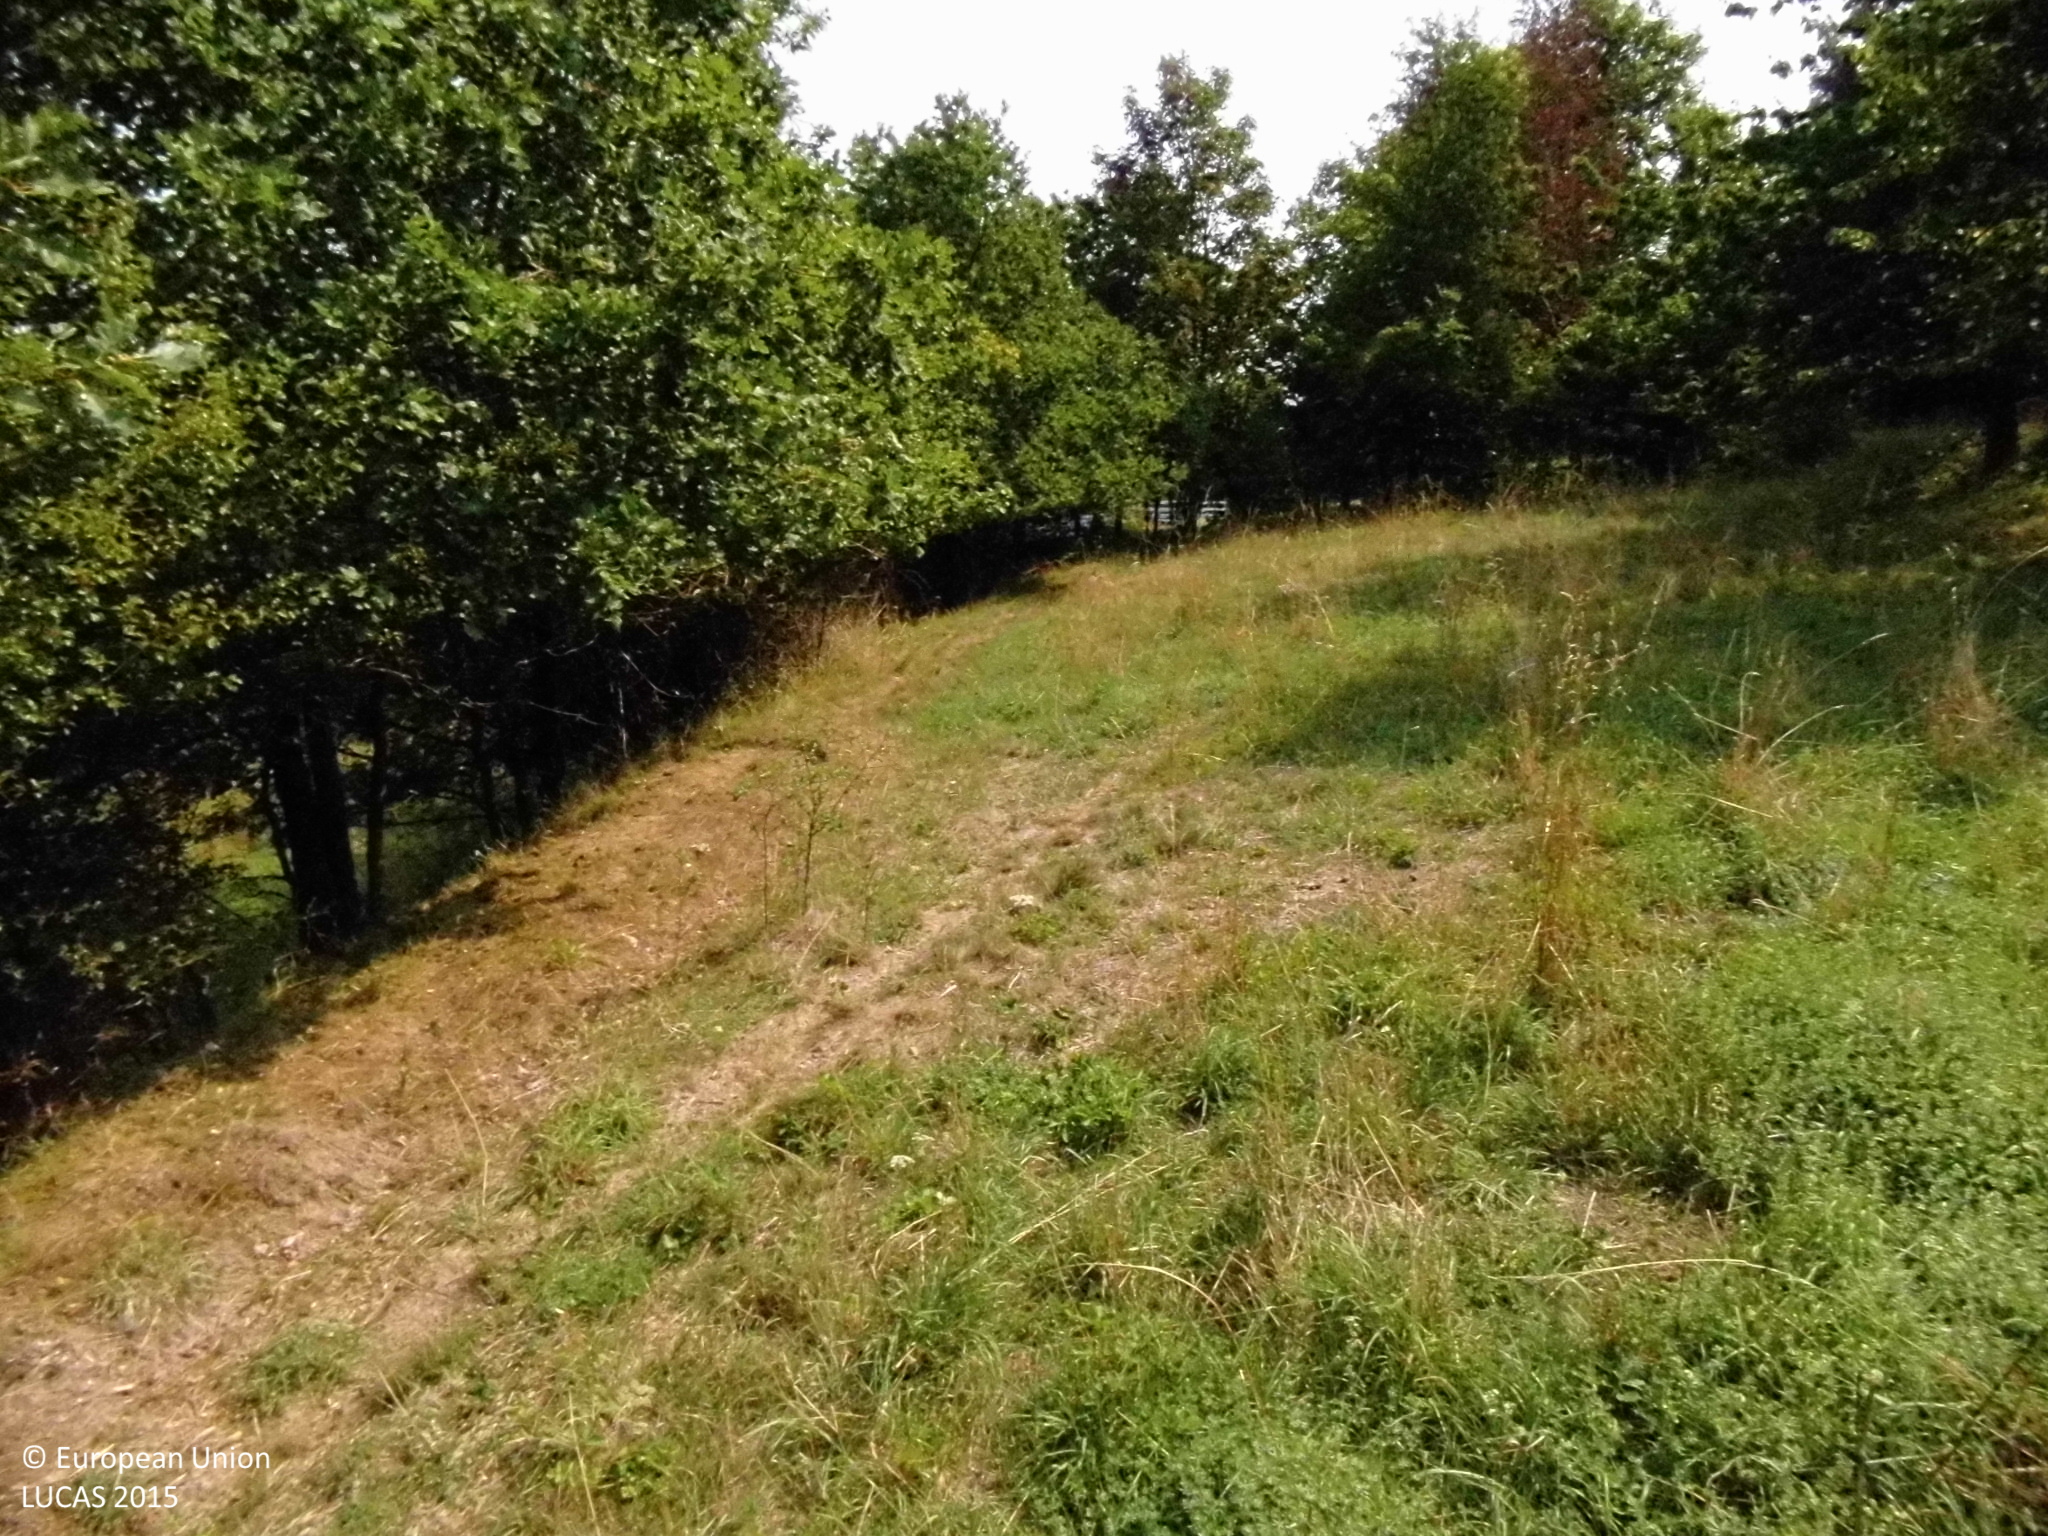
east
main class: Grassland
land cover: Grassland without tree/shrub cover
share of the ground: > 75 %
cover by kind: herbaceous plants 90 %, shrubs 5 %, unconsolidated bare surface 5 %
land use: Agriculture (excluding fallow land and kitchen gardens)
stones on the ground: 10 - 25 %
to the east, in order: Grassland without tree/shrub cover; Broadleaved woodland; Artificial constructions in urban areas; Broadleaved woodland; Tracks; Grassland without tree/shrub cover
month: August
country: DE
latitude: 50.6972
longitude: 8.5988
